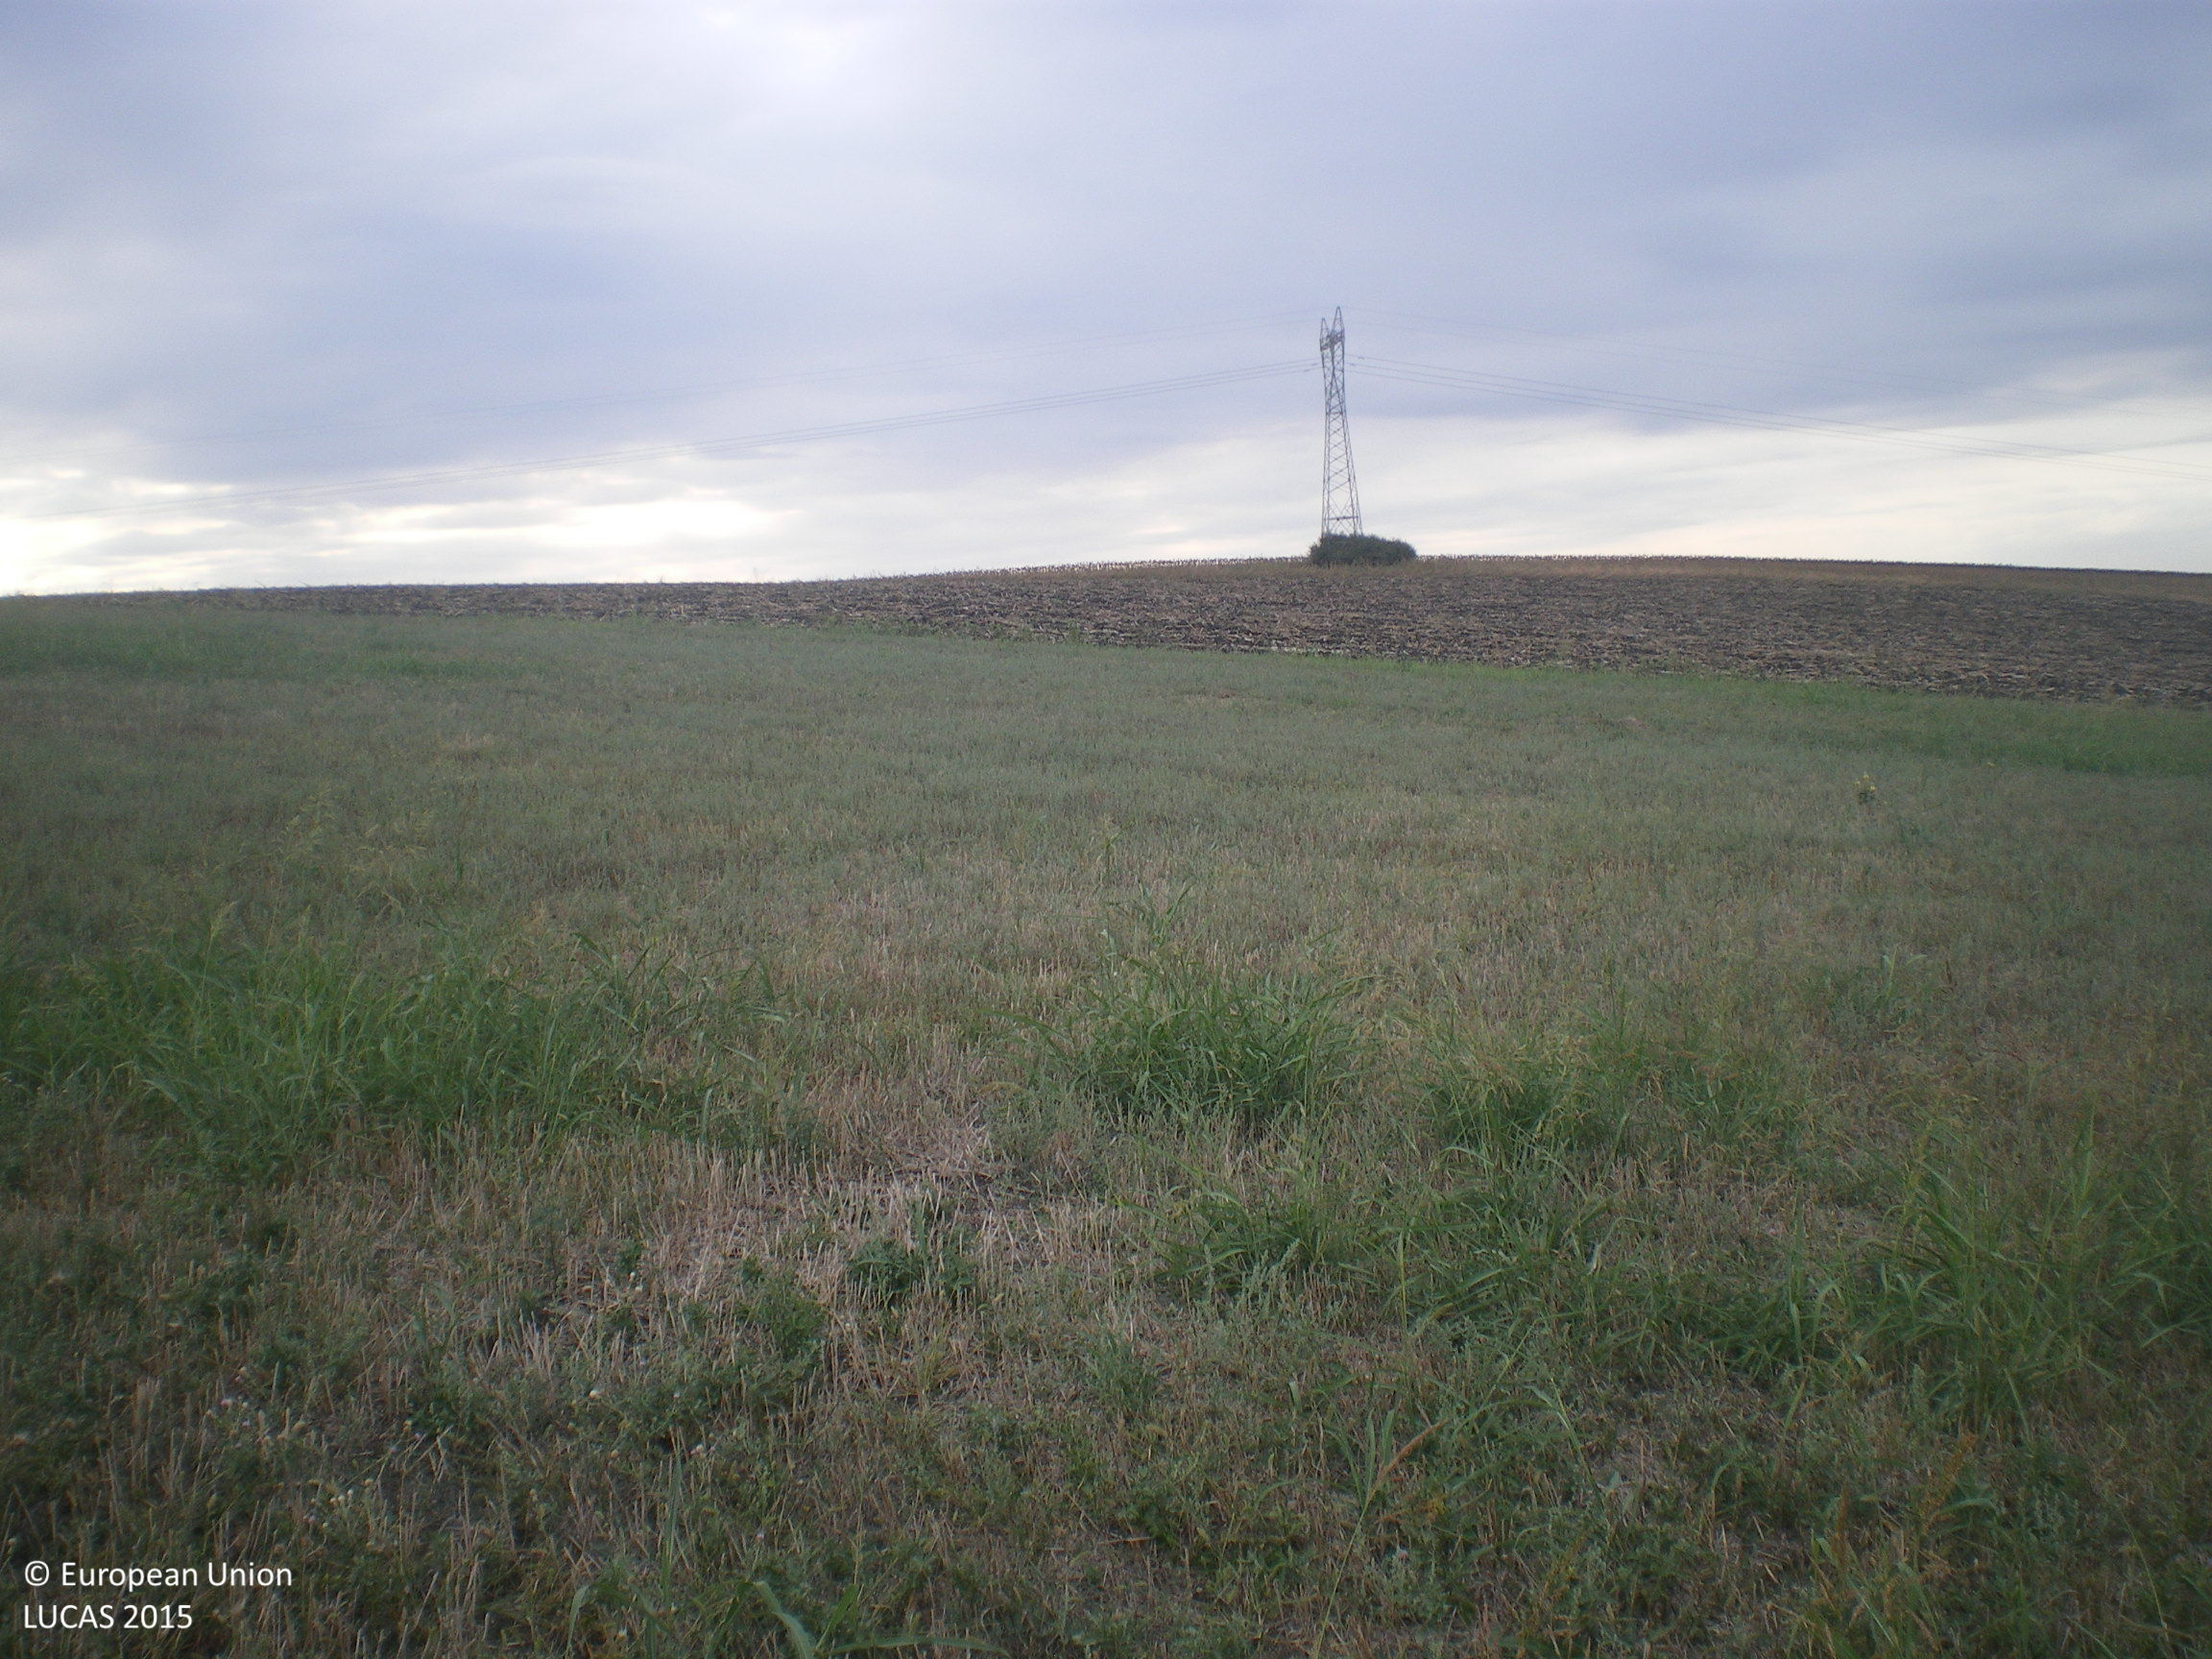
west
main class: Cropland
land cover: Rye
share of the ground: 10 - 25 %
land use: Agriculture (excluding fallow land and kitchen gardens)
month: September
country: BG
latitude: 42.2255
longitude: 25.8363
